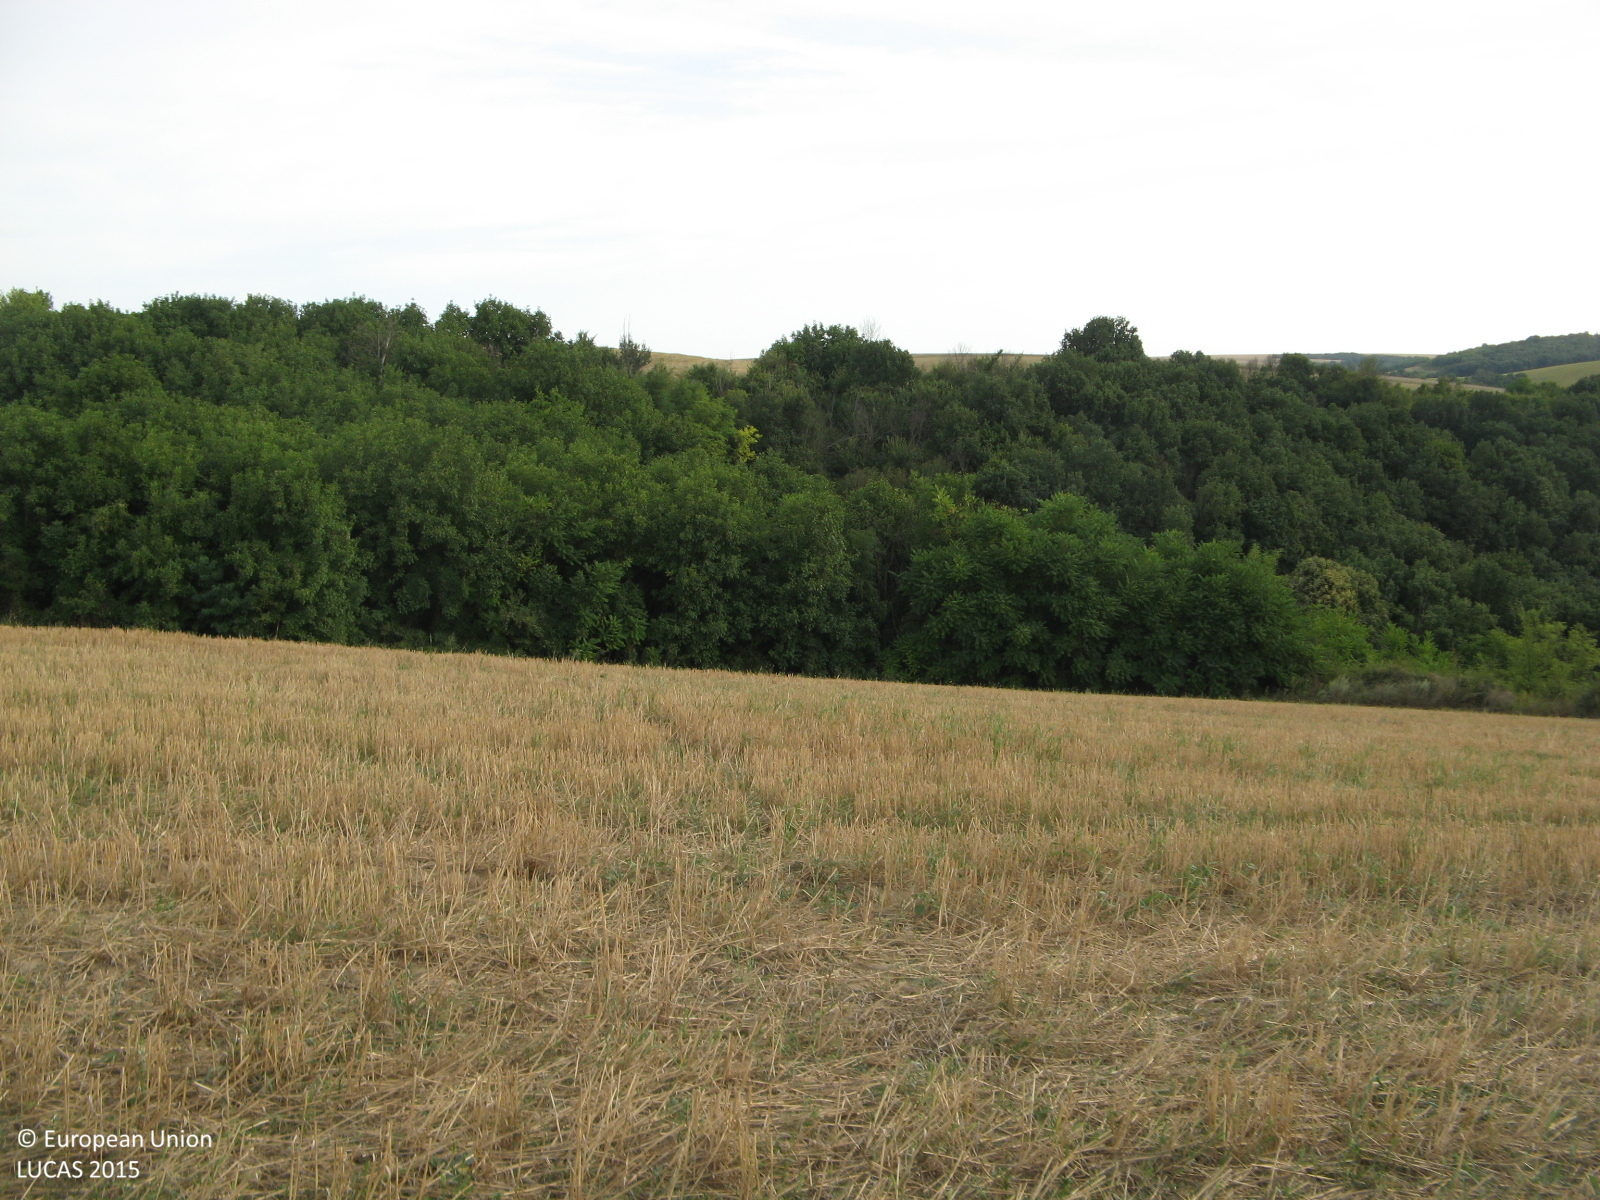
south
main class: Cropland
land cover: Common wheat
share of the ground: 25 - 50 %
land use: Agriculture (excluding fallow land and kitchen gardens)
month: August
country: BG
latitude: 43.6214
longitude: 25.7143
